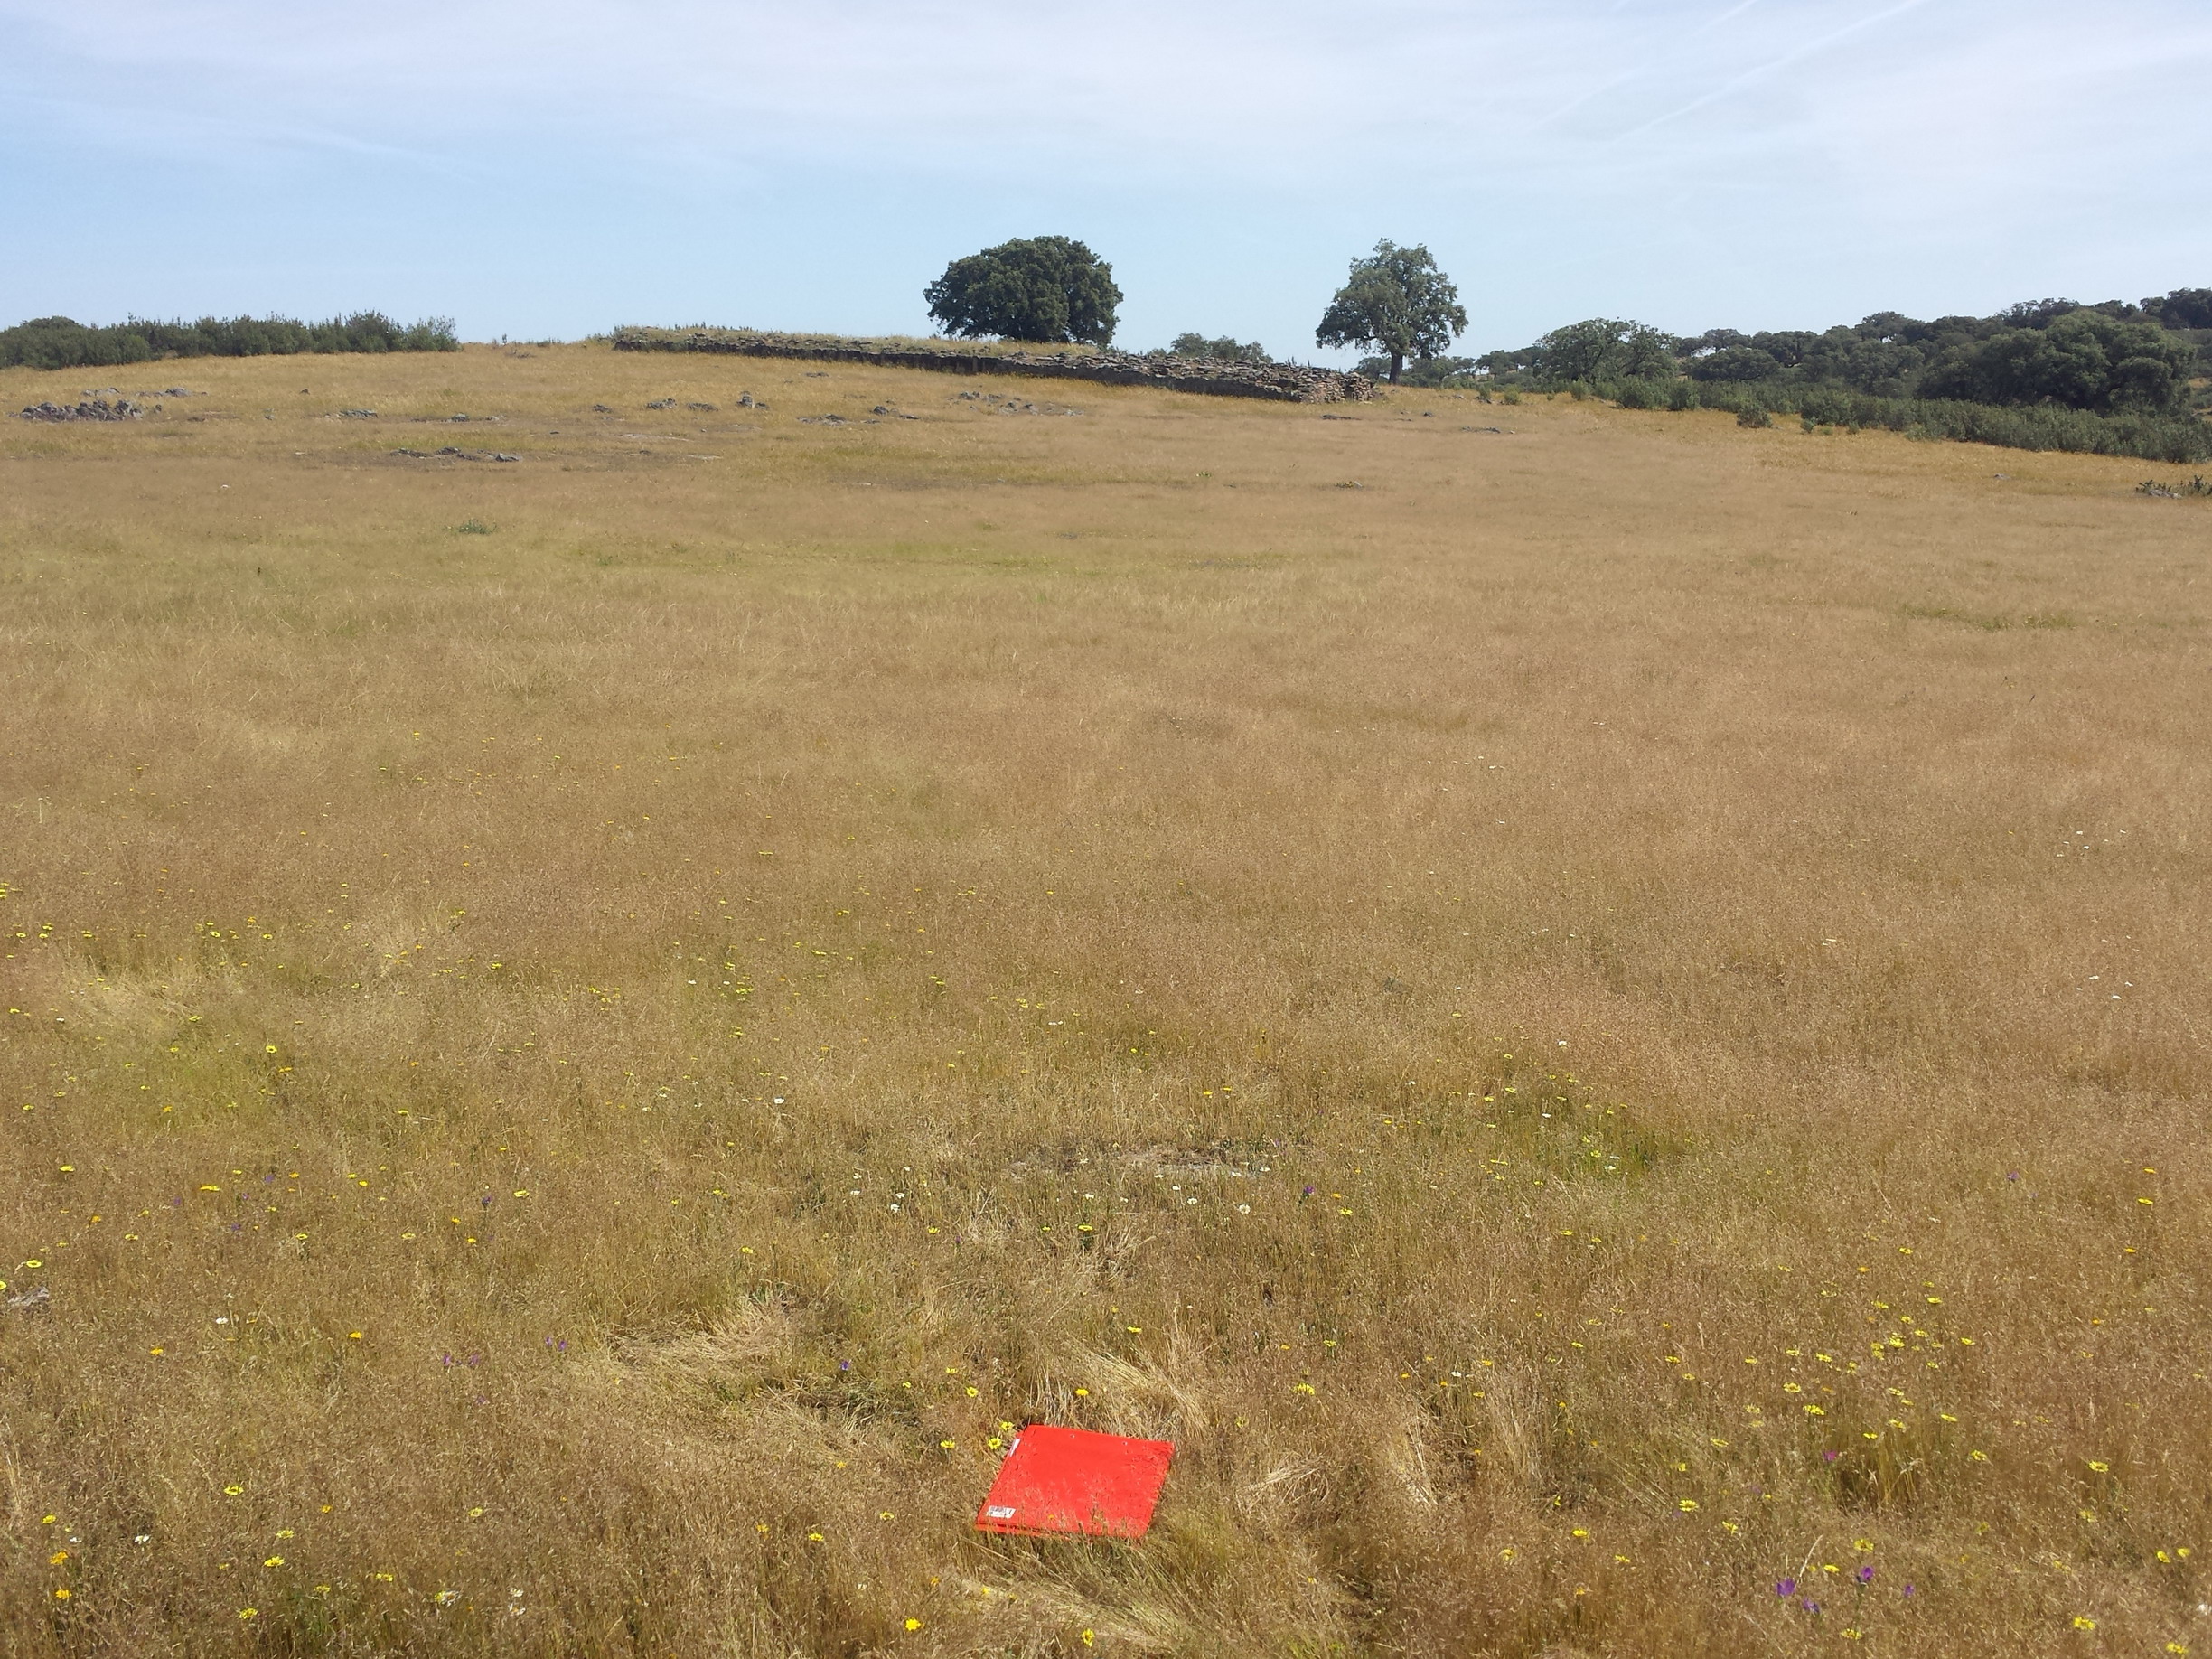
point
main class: Grassland
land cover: Grassland without tree/shrub cover
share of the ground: > 75 %
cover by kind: herbaceous plants 100 %
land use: Agriculture (excluding fallow land and kitchen gardens)
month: May
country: ES
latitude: 39.6154
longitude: -7.1280
